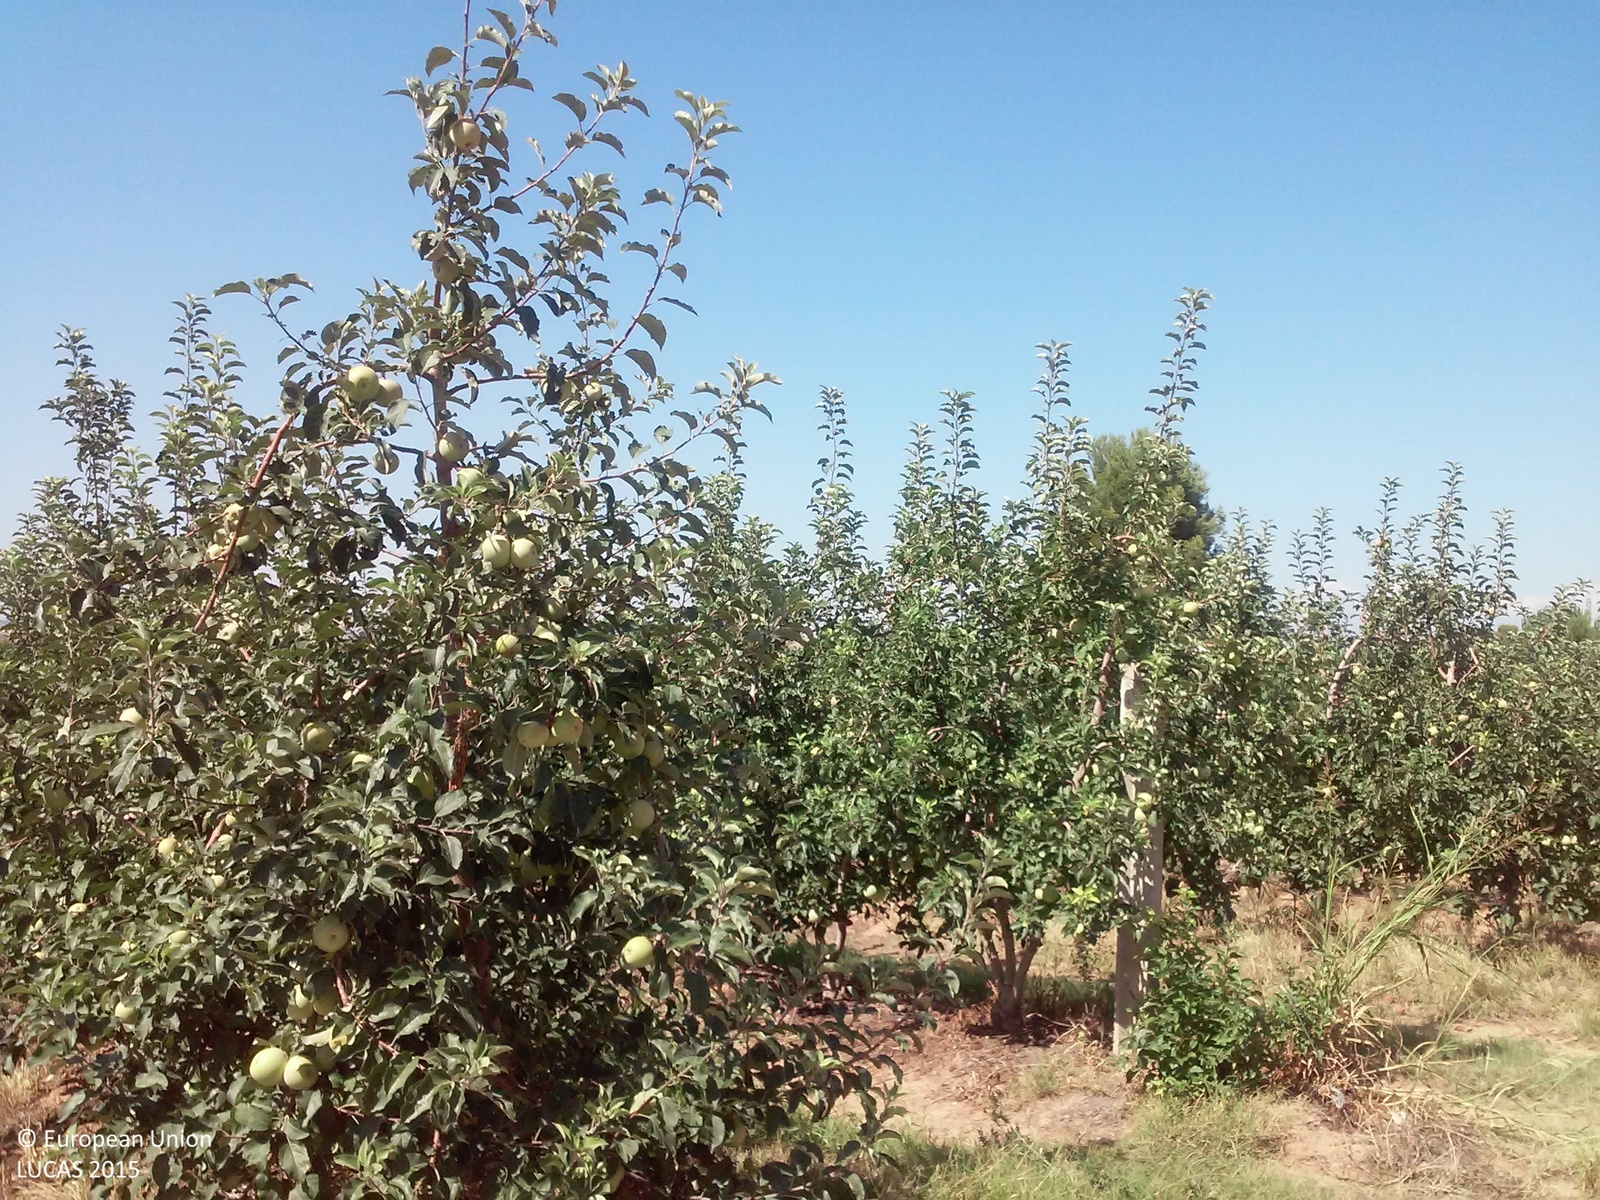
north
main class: Cropland
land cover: Apple fruit
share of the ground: 10 - 25 %
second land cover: Grassland without tree/shrub cover
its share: > 75 %
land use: Agriculture (excluding fallow land and kitchen gardens)
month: July
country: ES
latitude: 41.5952
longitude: 0.5699
